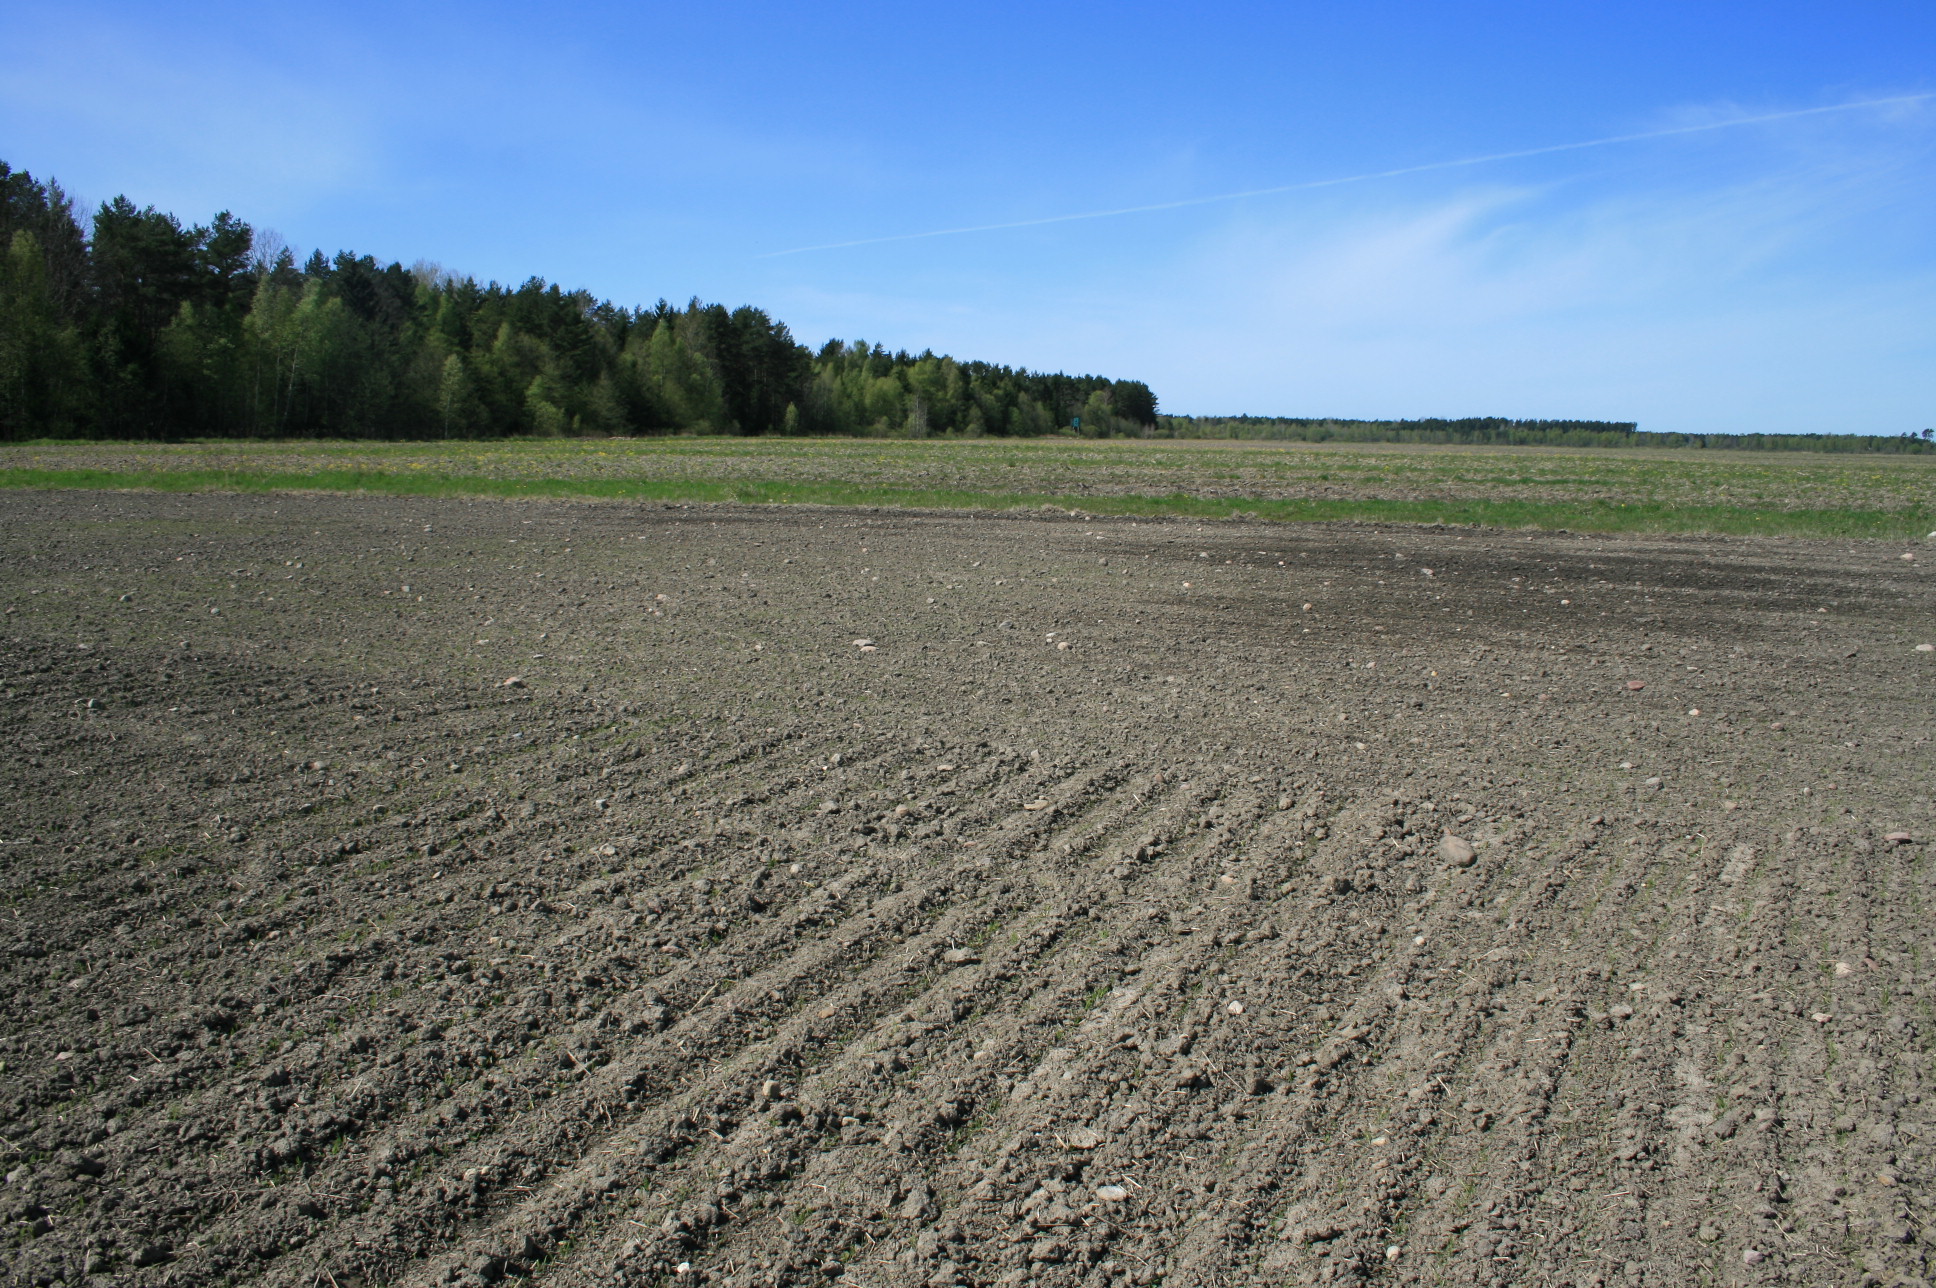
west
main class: Cropland
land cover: Common wheat
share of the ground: 10 - 25 %
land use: Agriculture (excluding fallow land and kitchen gardens)
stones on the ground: < 10 %
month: May
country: LT
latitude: 56.1010
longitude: 21.3436
